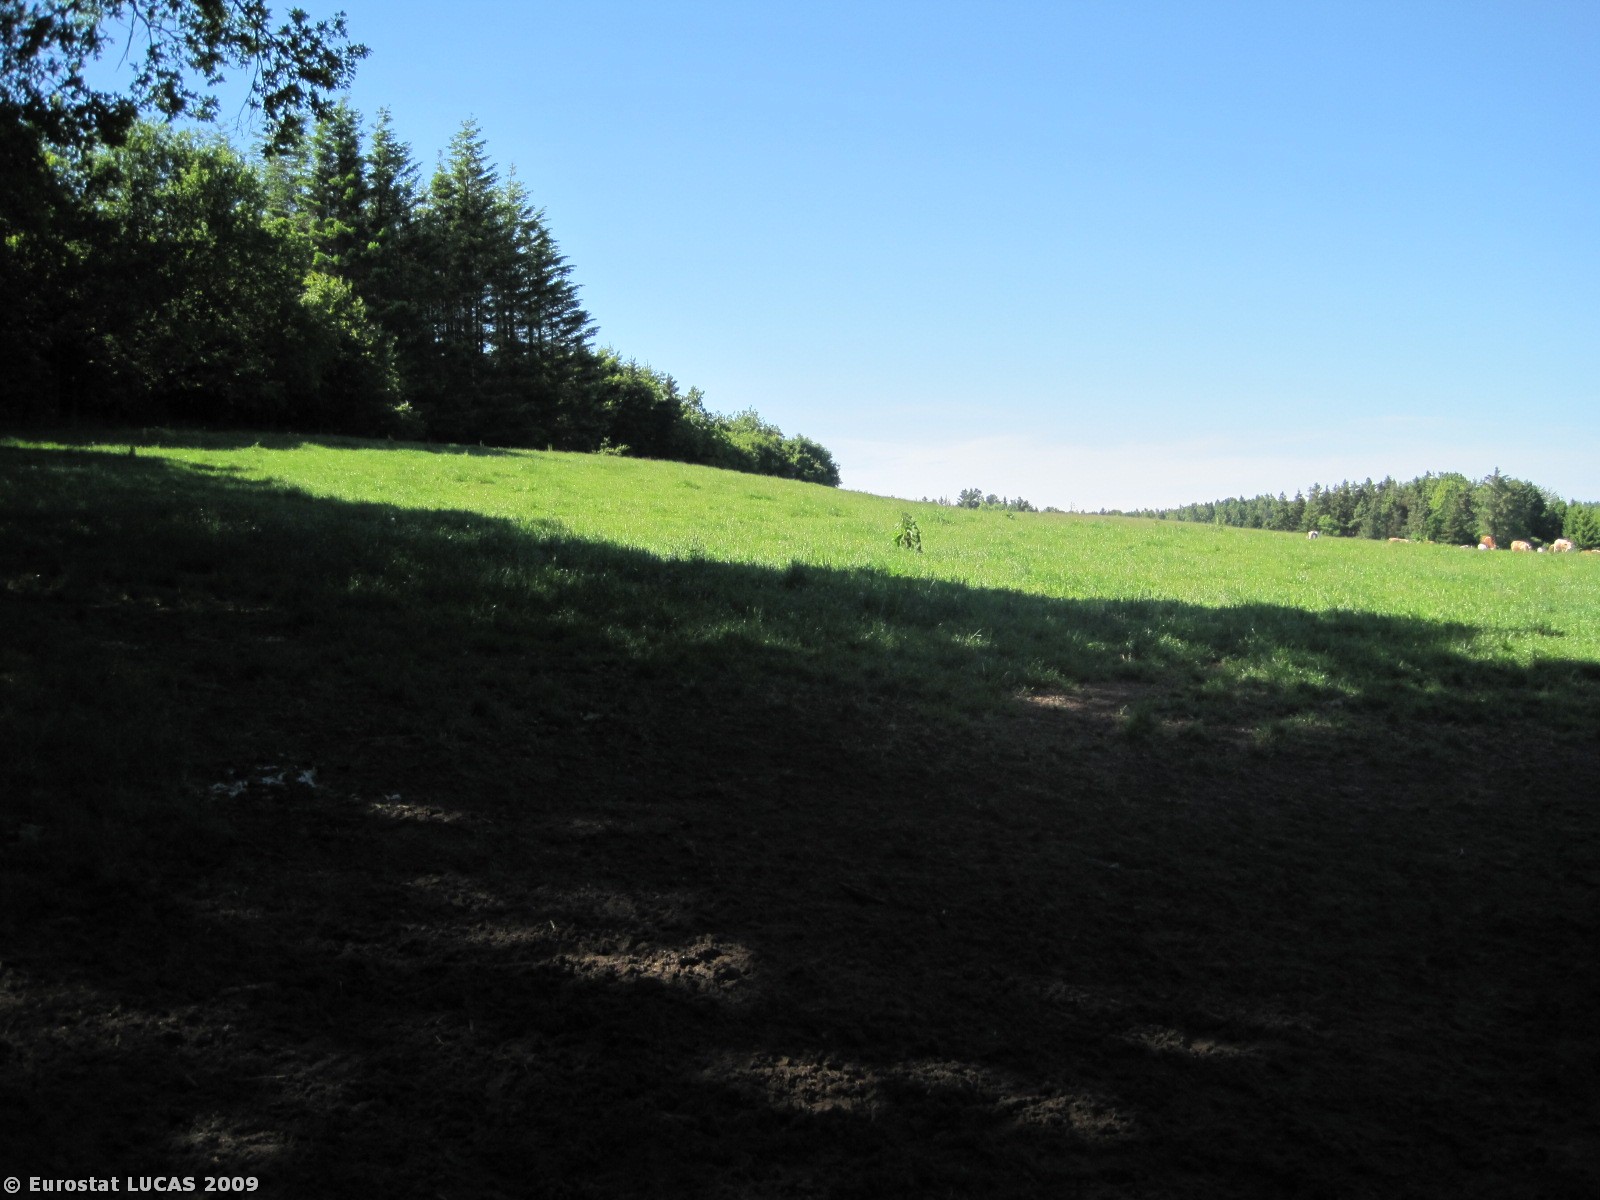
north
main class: Grassland
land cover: Grassland without tree/shrub cover
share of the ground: > 75 %
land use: Agriculture (excluding fallow land and kitchen gardens)
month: June
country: DK
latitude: 57.5181
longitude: 10.0833
